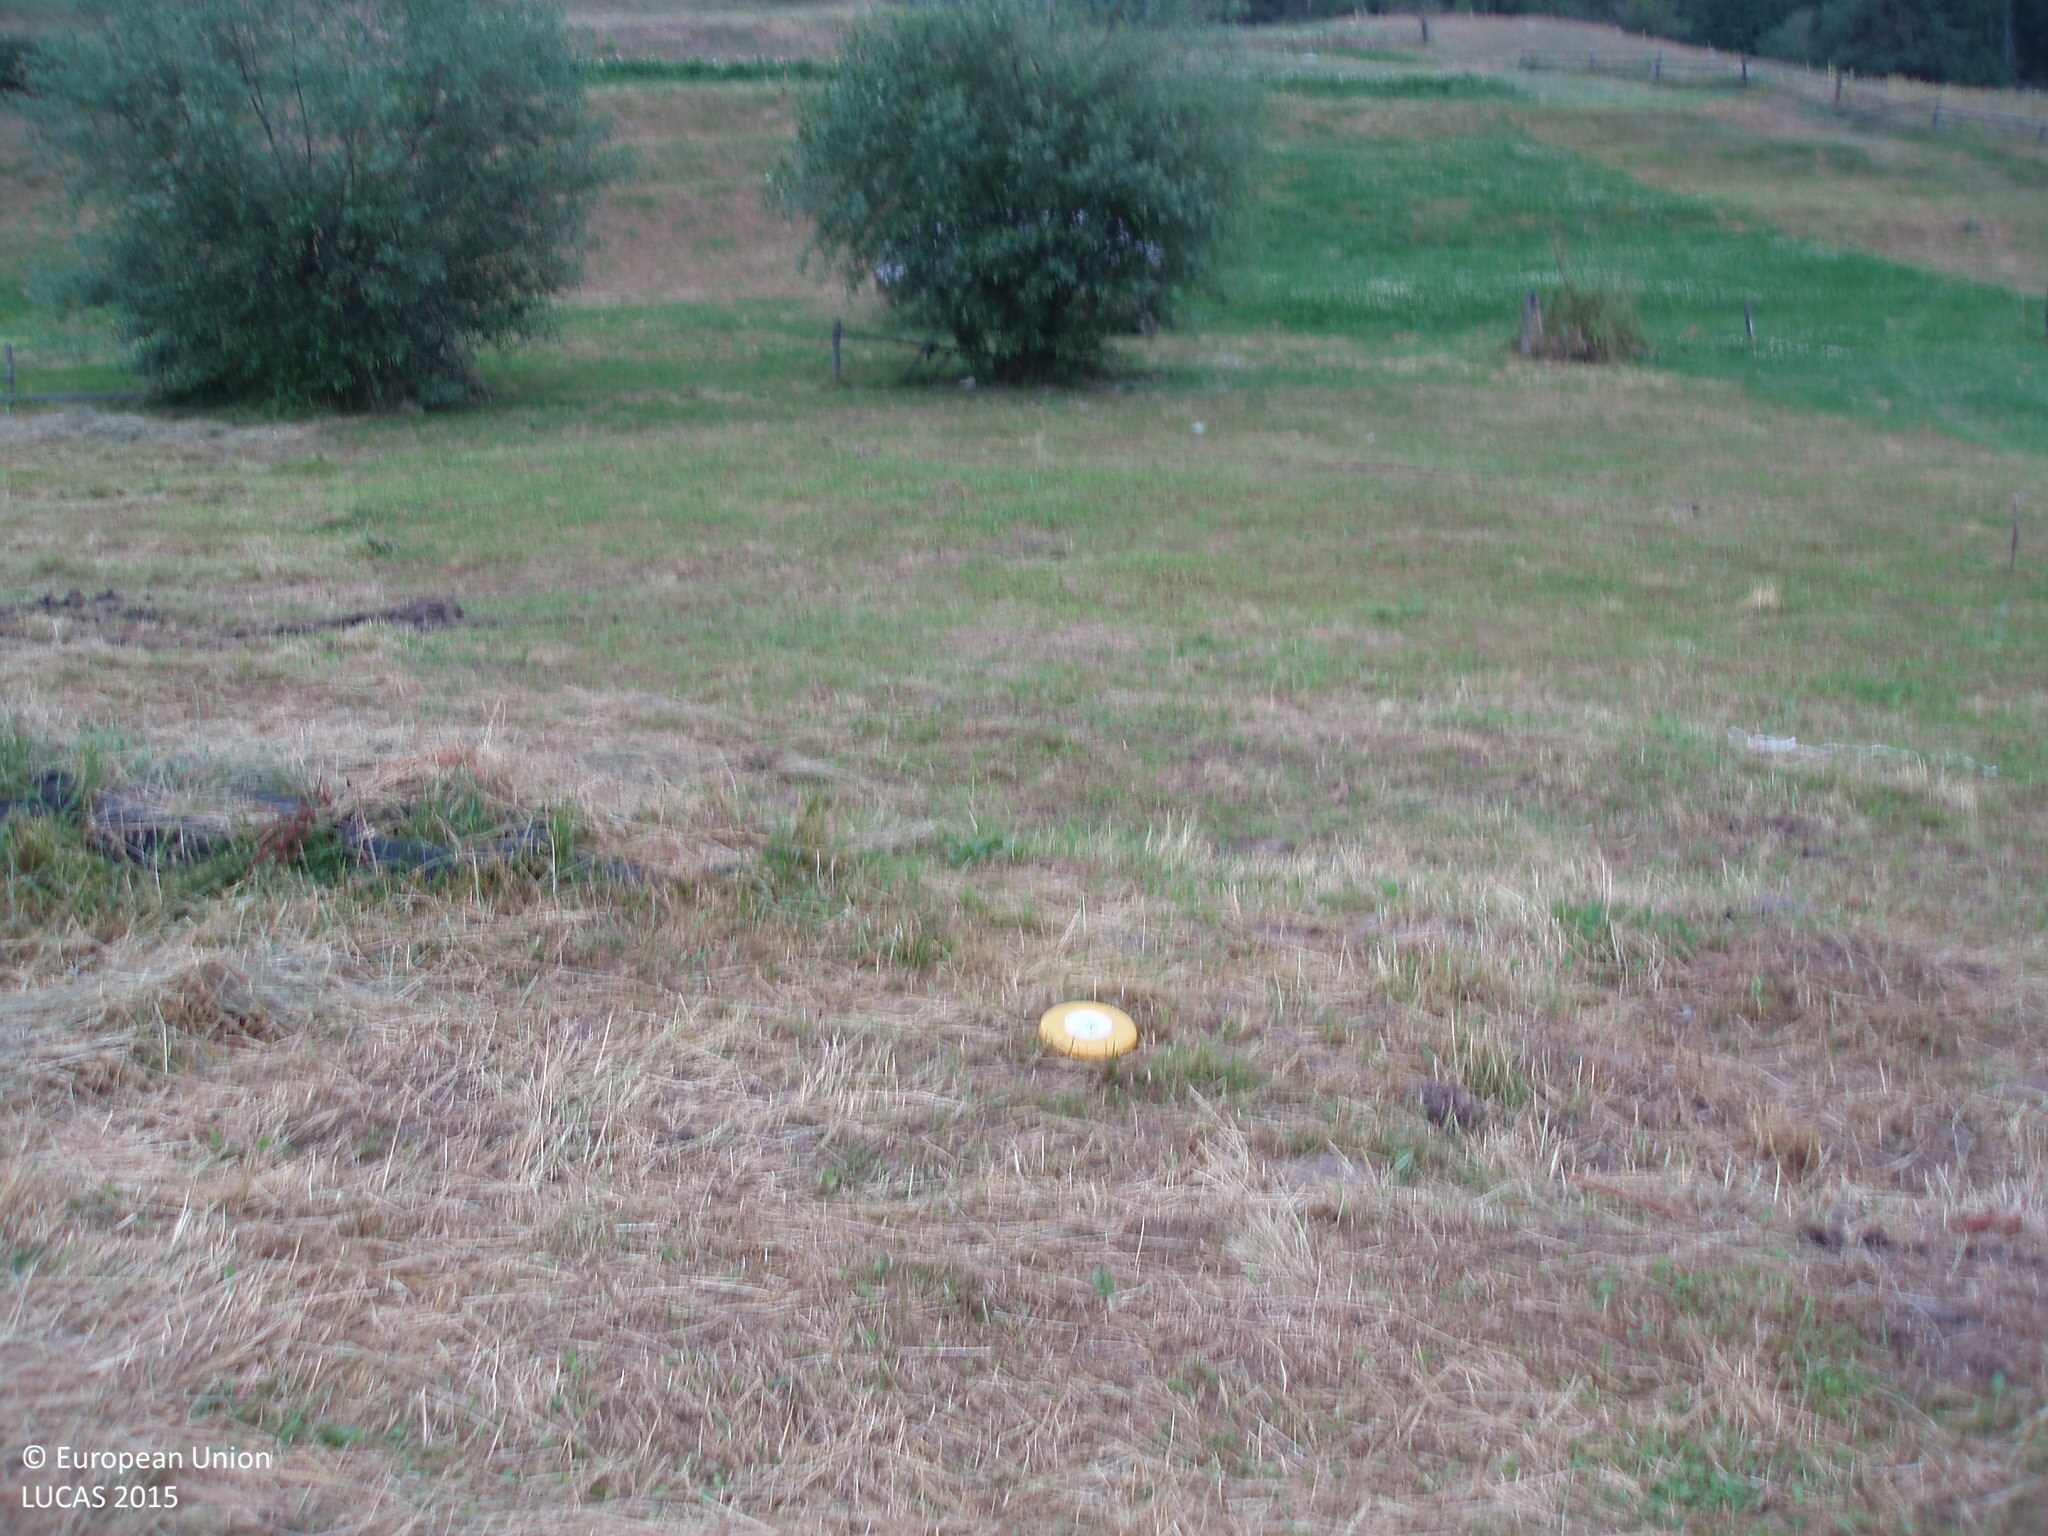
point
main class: Grassland
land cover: Grassland without tree/shrub cover
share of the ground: > 75 %
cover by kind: herbaceous plants 100 %
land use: Agriculture (excluding fallow land and kitchen gardens)
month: July
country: BG
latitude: 42.0057
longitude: 23.7370
